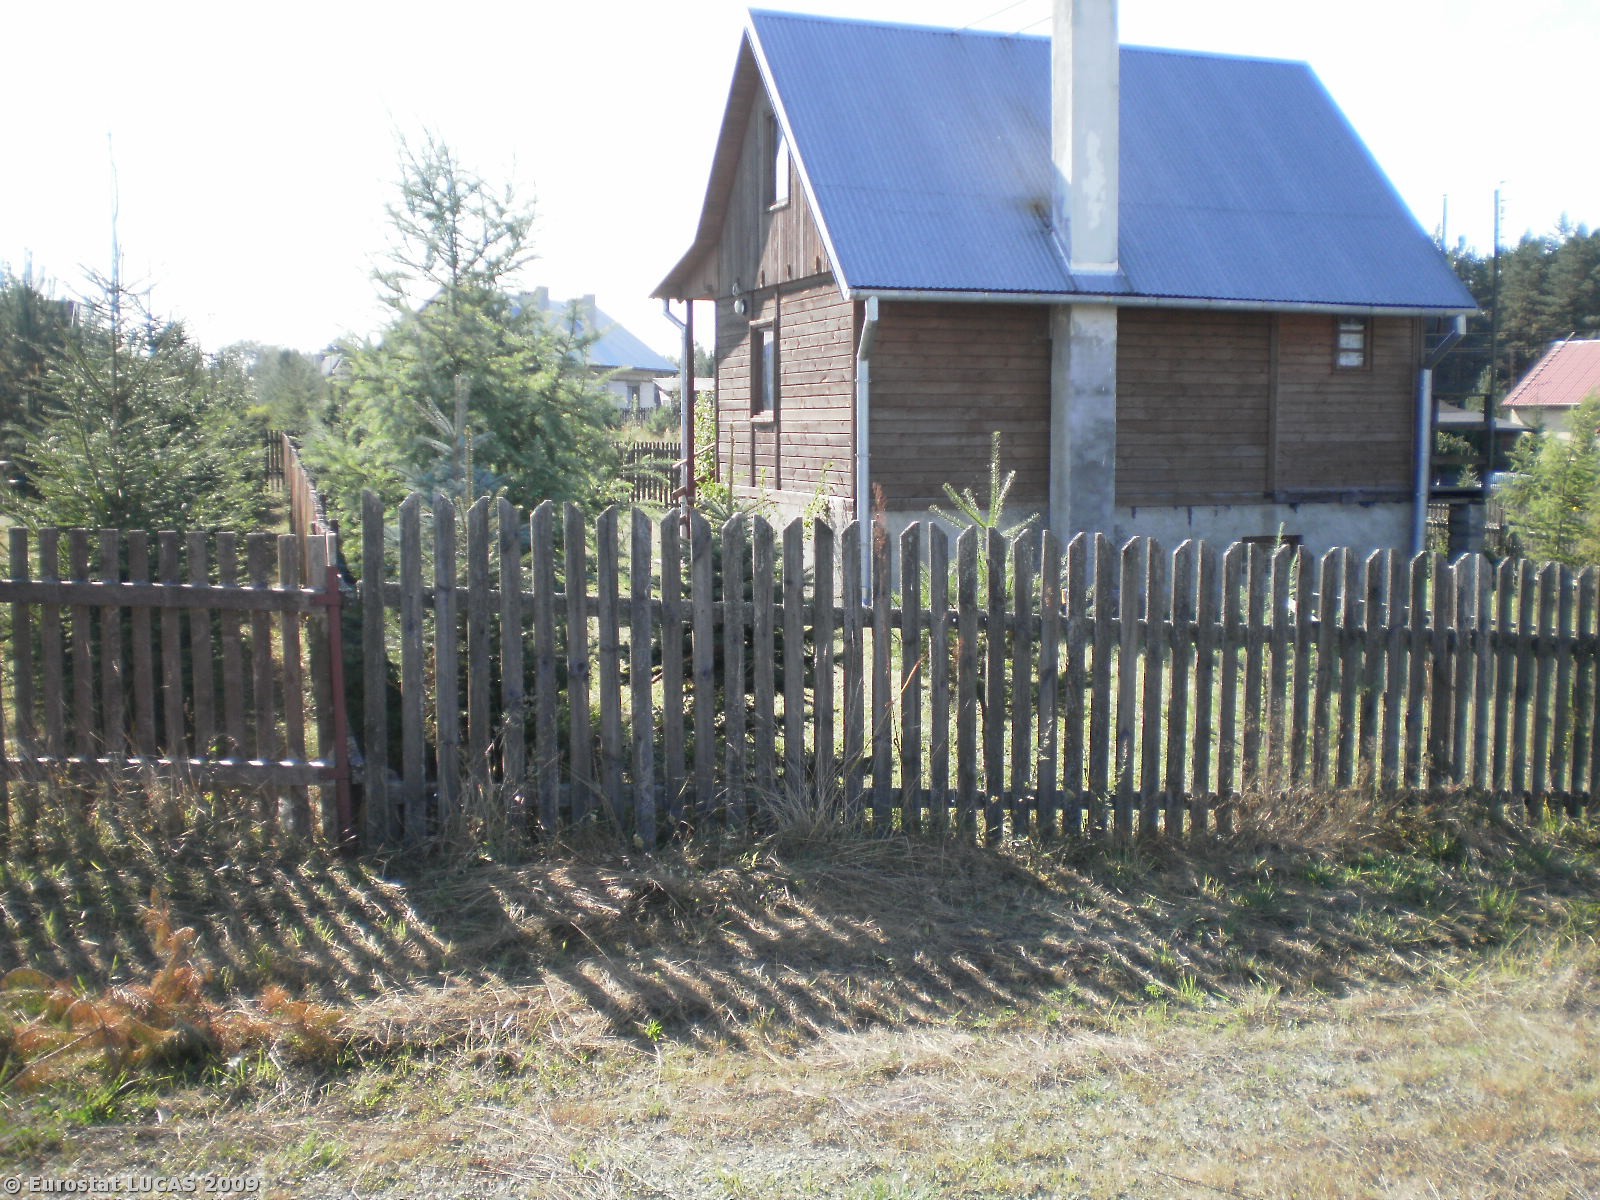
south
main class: Grassland
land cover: Grassland with sparse tree/shrub cover
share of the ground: > 75 %
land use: Agriculture (excluding fallow land and kitchen gardens)
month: September
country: PL
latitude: 53.6093
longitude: 21.3688
